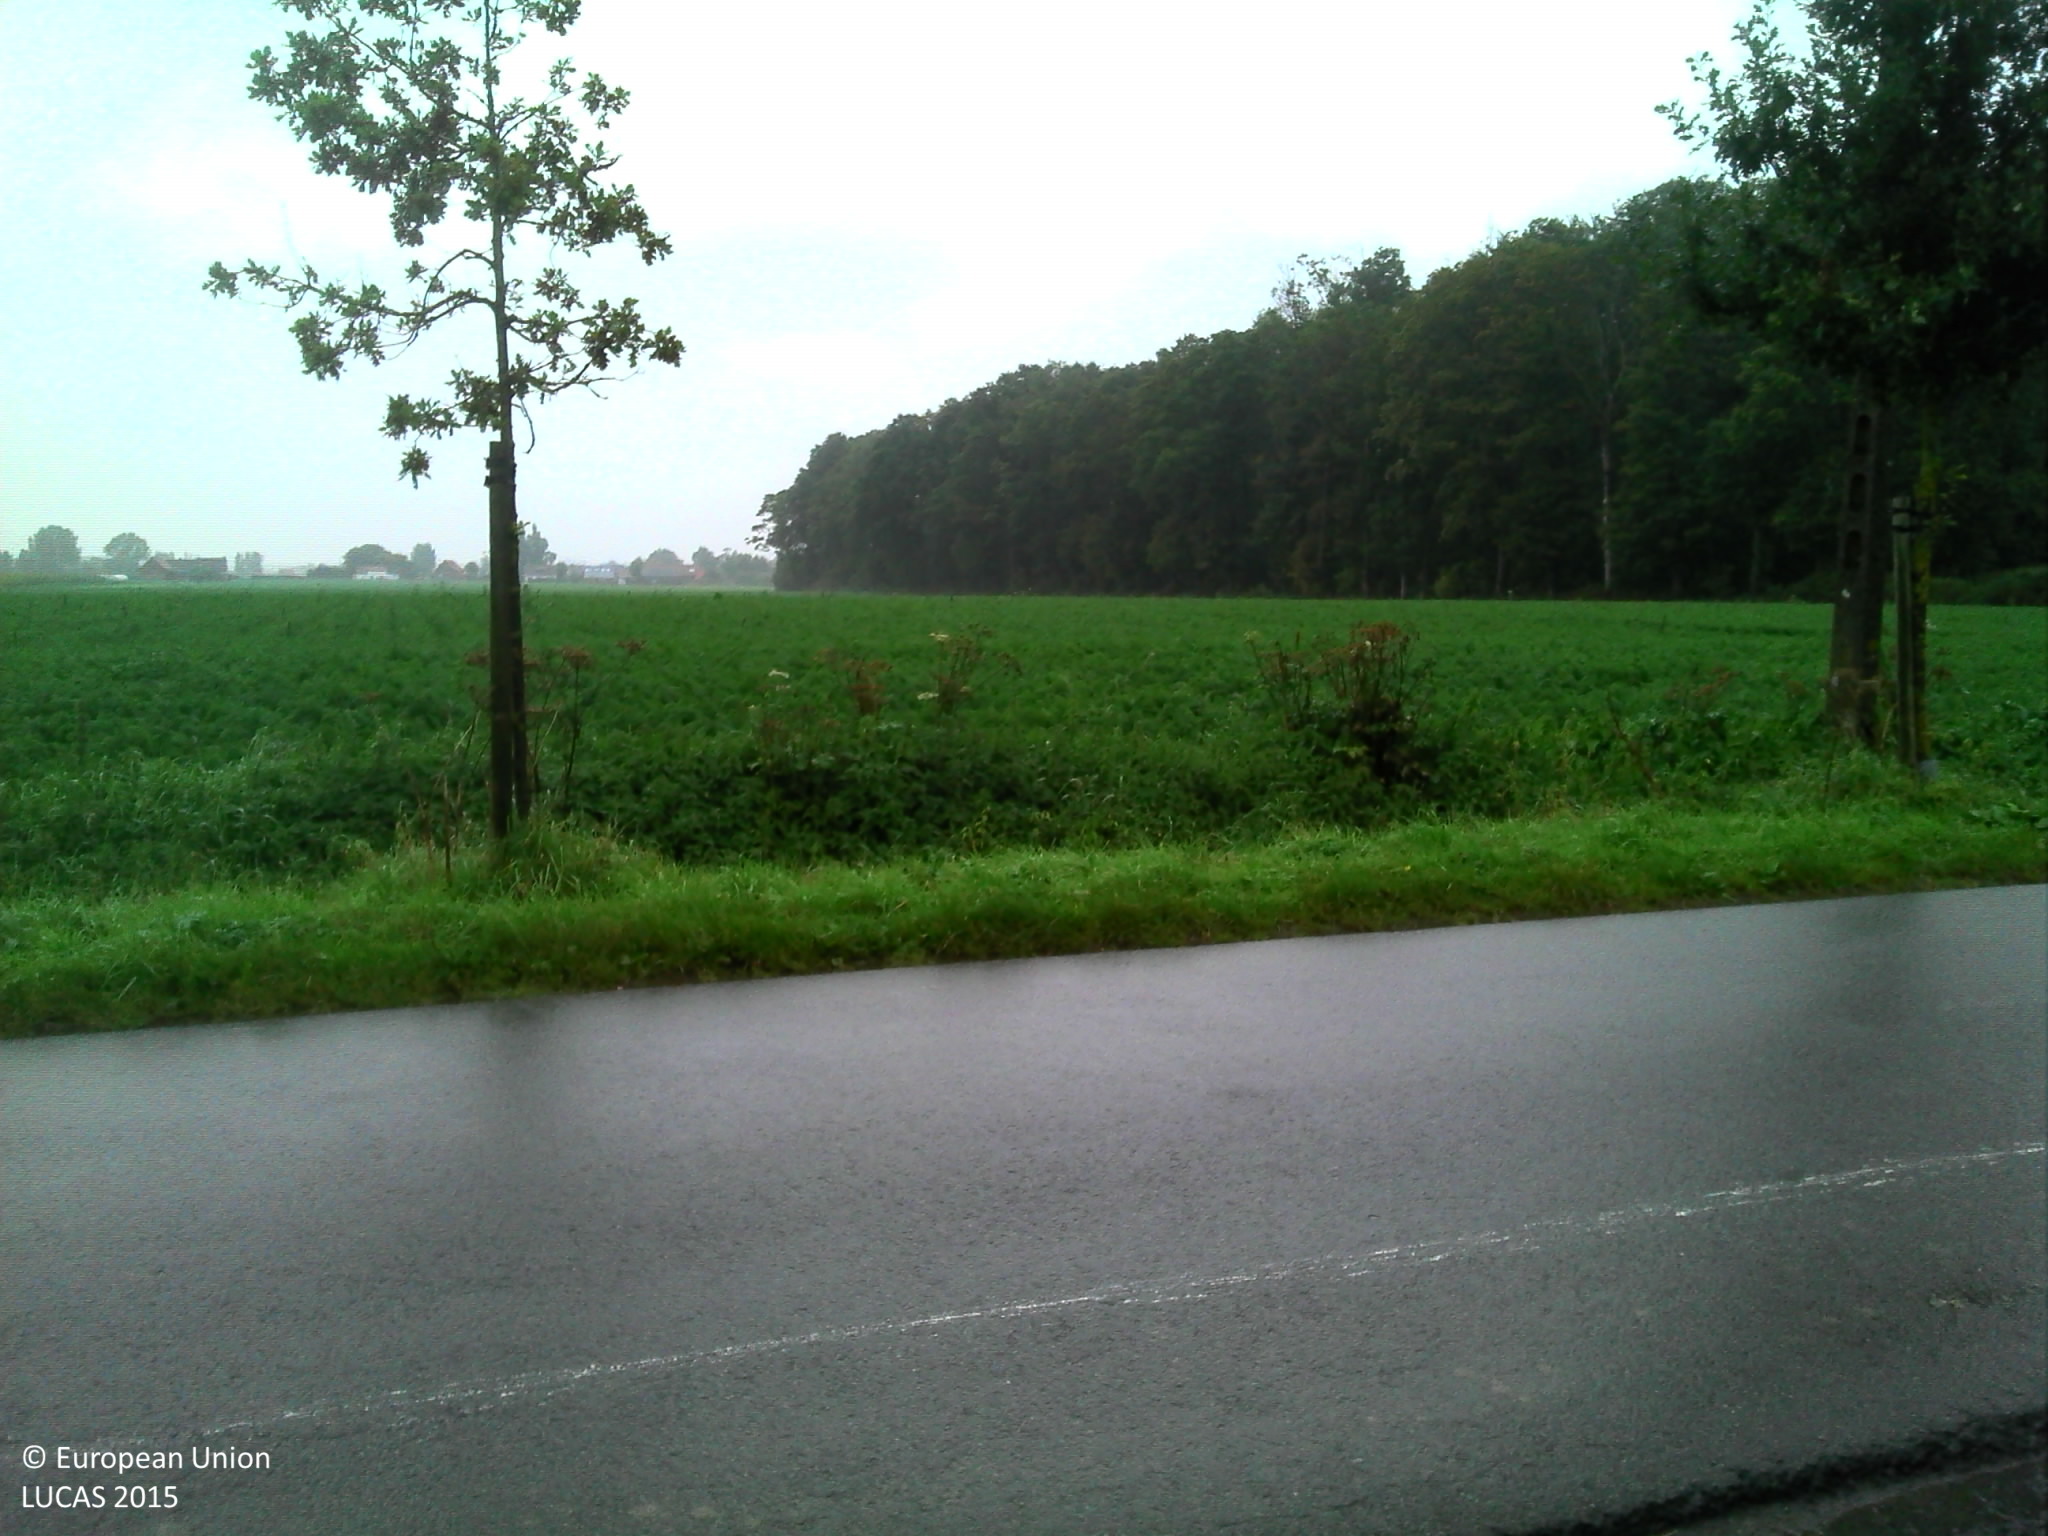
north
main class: Grassland
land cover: Grassland without tree/shrub cover
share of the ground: > 75 %
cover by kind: herbaceous plants 100 %
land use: Residential
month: October
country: BE
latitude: 50.9565
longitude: 2.9140
